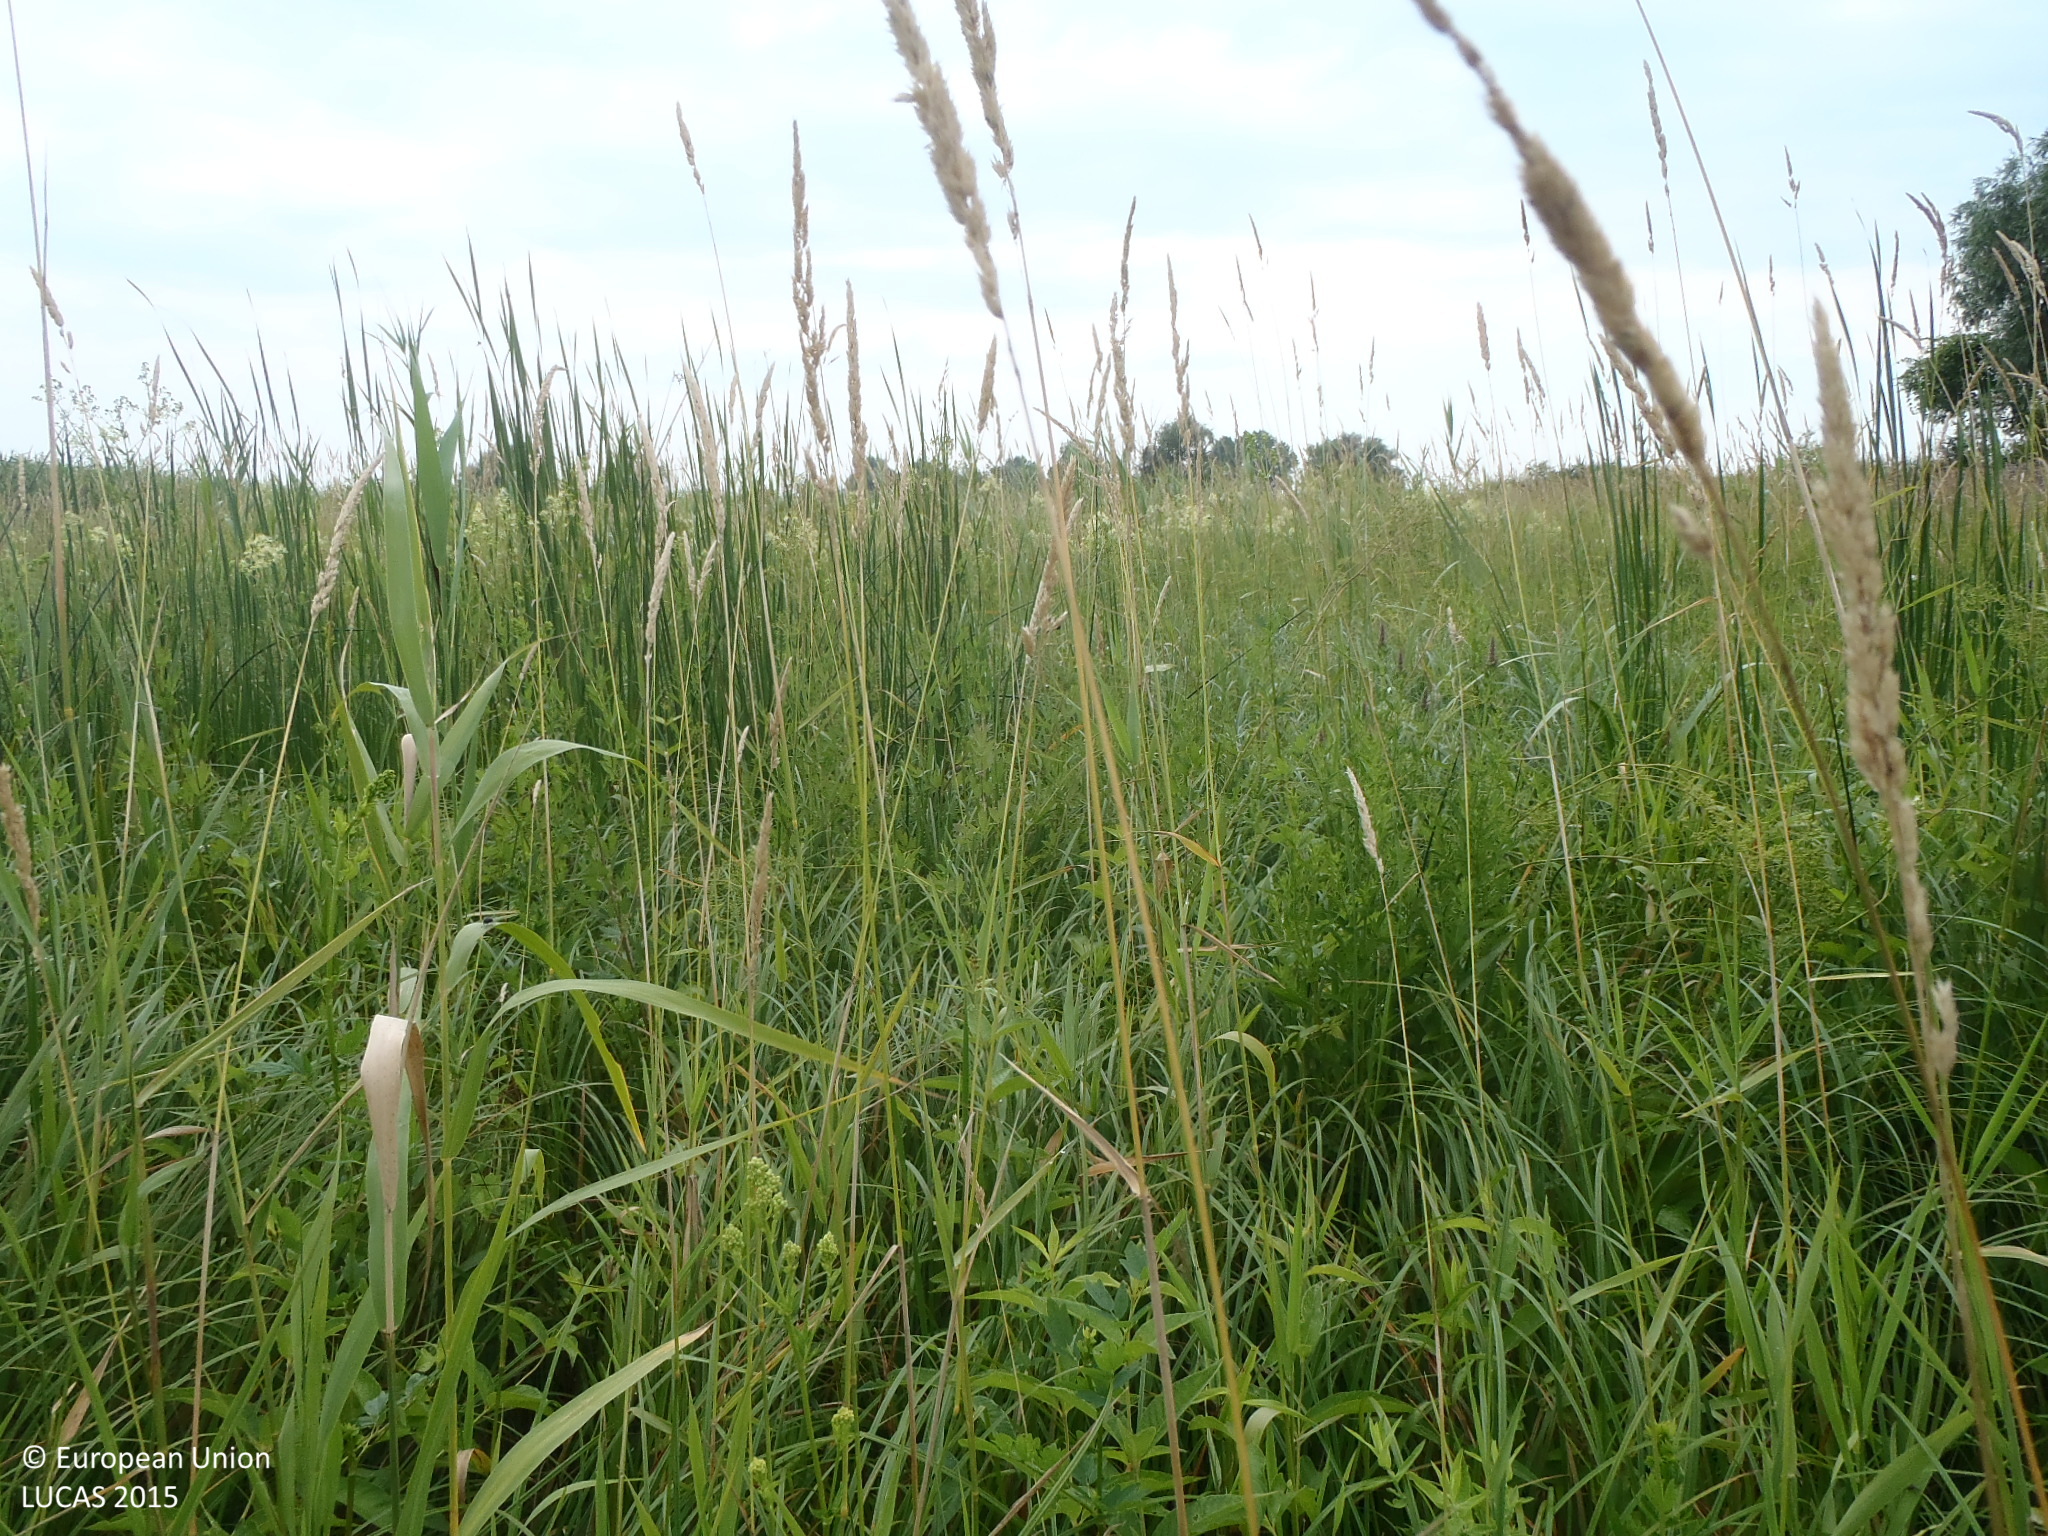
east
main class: Grassland
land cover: Spontaneously vegetated surfaces
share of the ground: > 75 %
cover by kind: herbaceous plants 95 %, shrubs 5 %
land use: Semi-natural and natural areas not in use
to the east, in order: Spontaneously vegetated surfaces
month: July
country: BG
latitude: 44.0016
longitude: 26.3312
